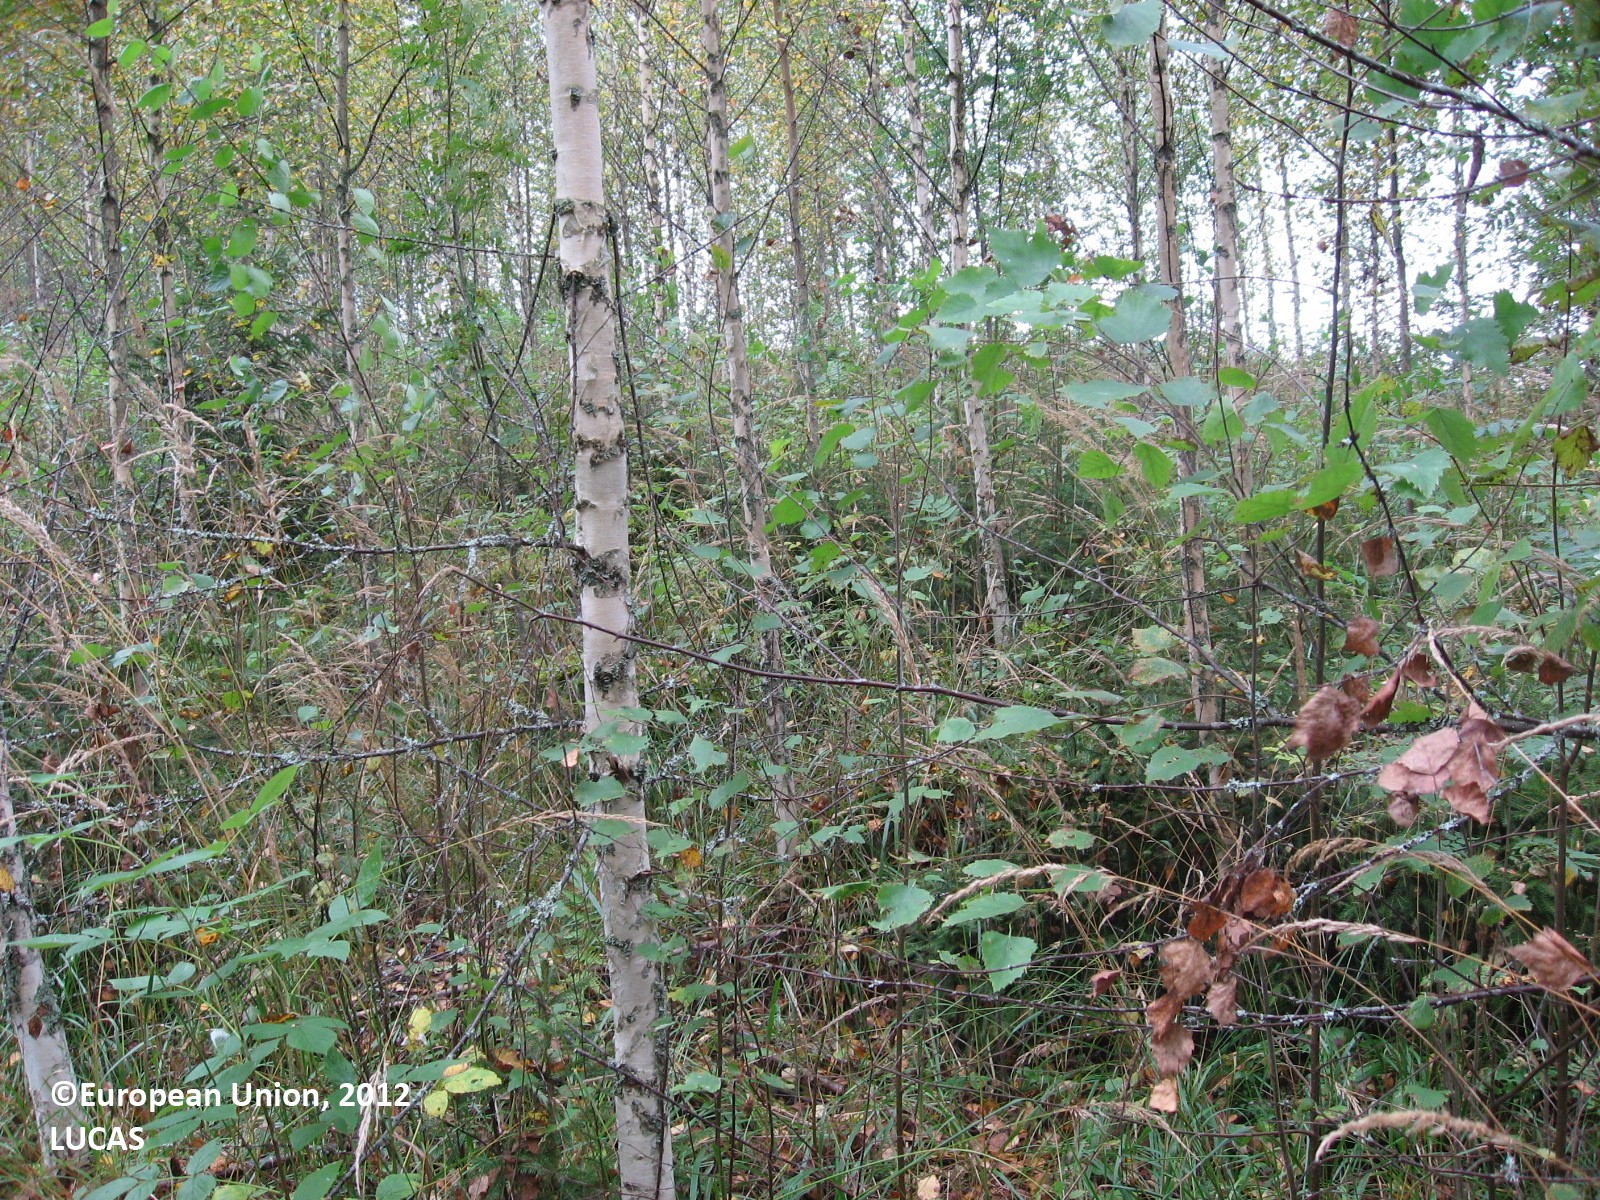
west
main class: Woodland
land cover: Broadleaved woodland
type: boreal forest
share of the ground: > 75 %
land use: Forestry
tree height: > 5 m
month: September
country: FI
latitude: 60.8797
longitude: 25.1685
